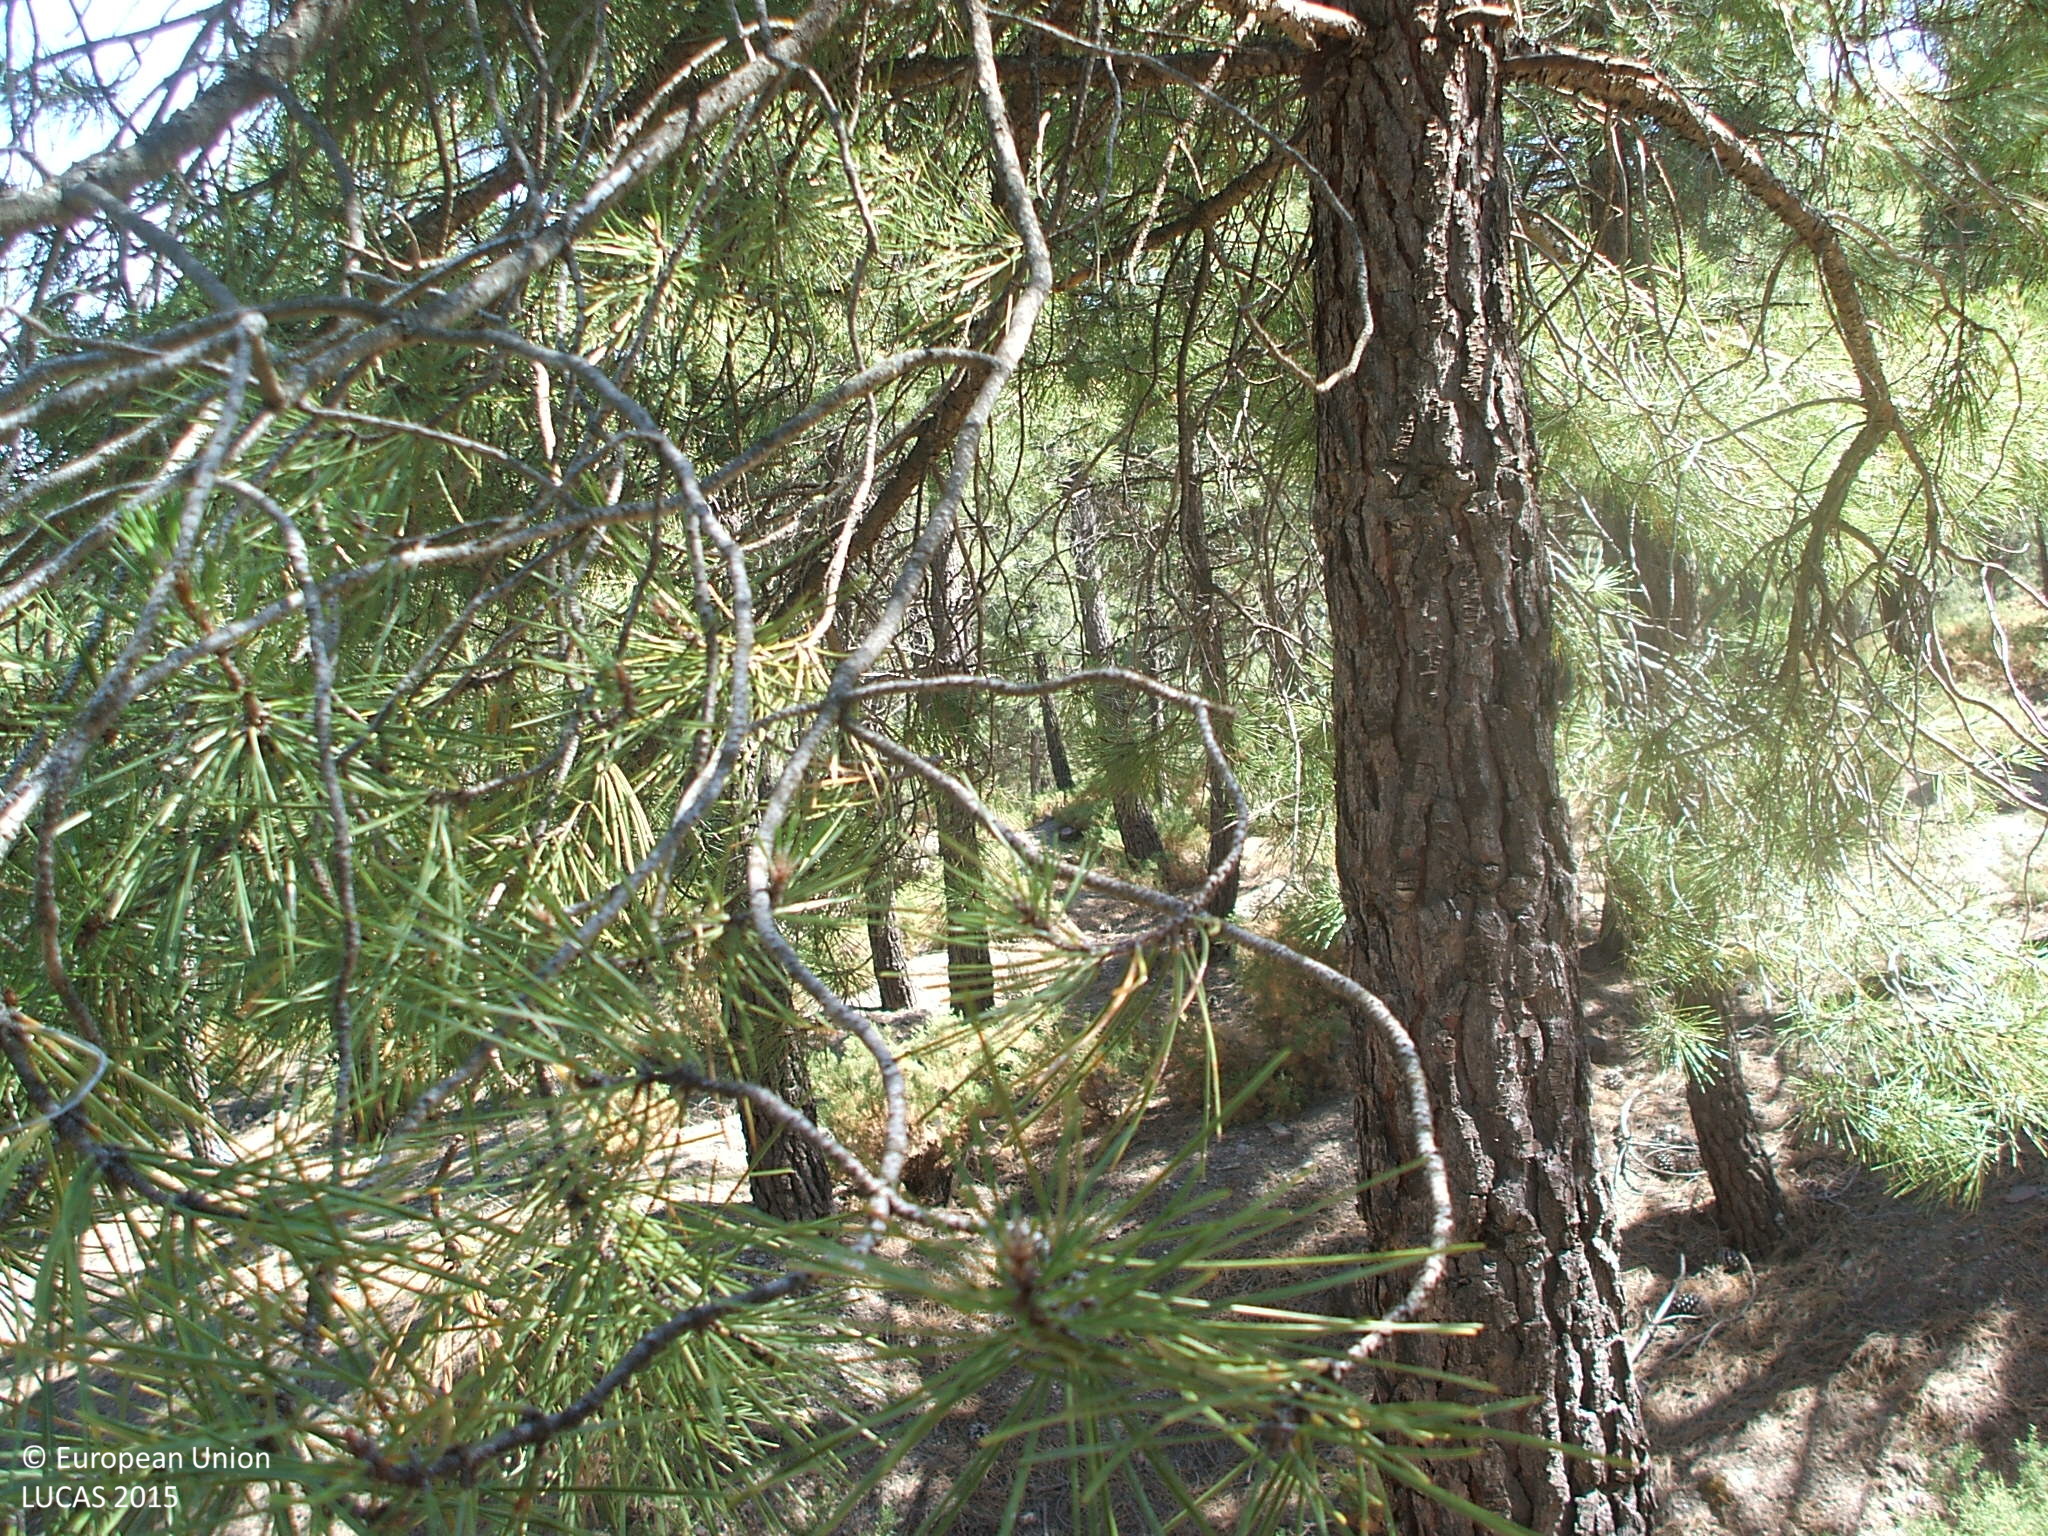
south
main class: Woodland
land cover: Pine dominated coniferous woodland
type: coniferous forest of the mediterranean region
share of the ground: > 75 %
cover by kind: coniferous forest trees 80 %, shrubs 20 %
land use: Semi-natural and natural areas not in use
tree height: > 5 m
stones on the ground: > 50 %
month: June
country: ES
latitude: 37.1022
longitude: -2.7748
